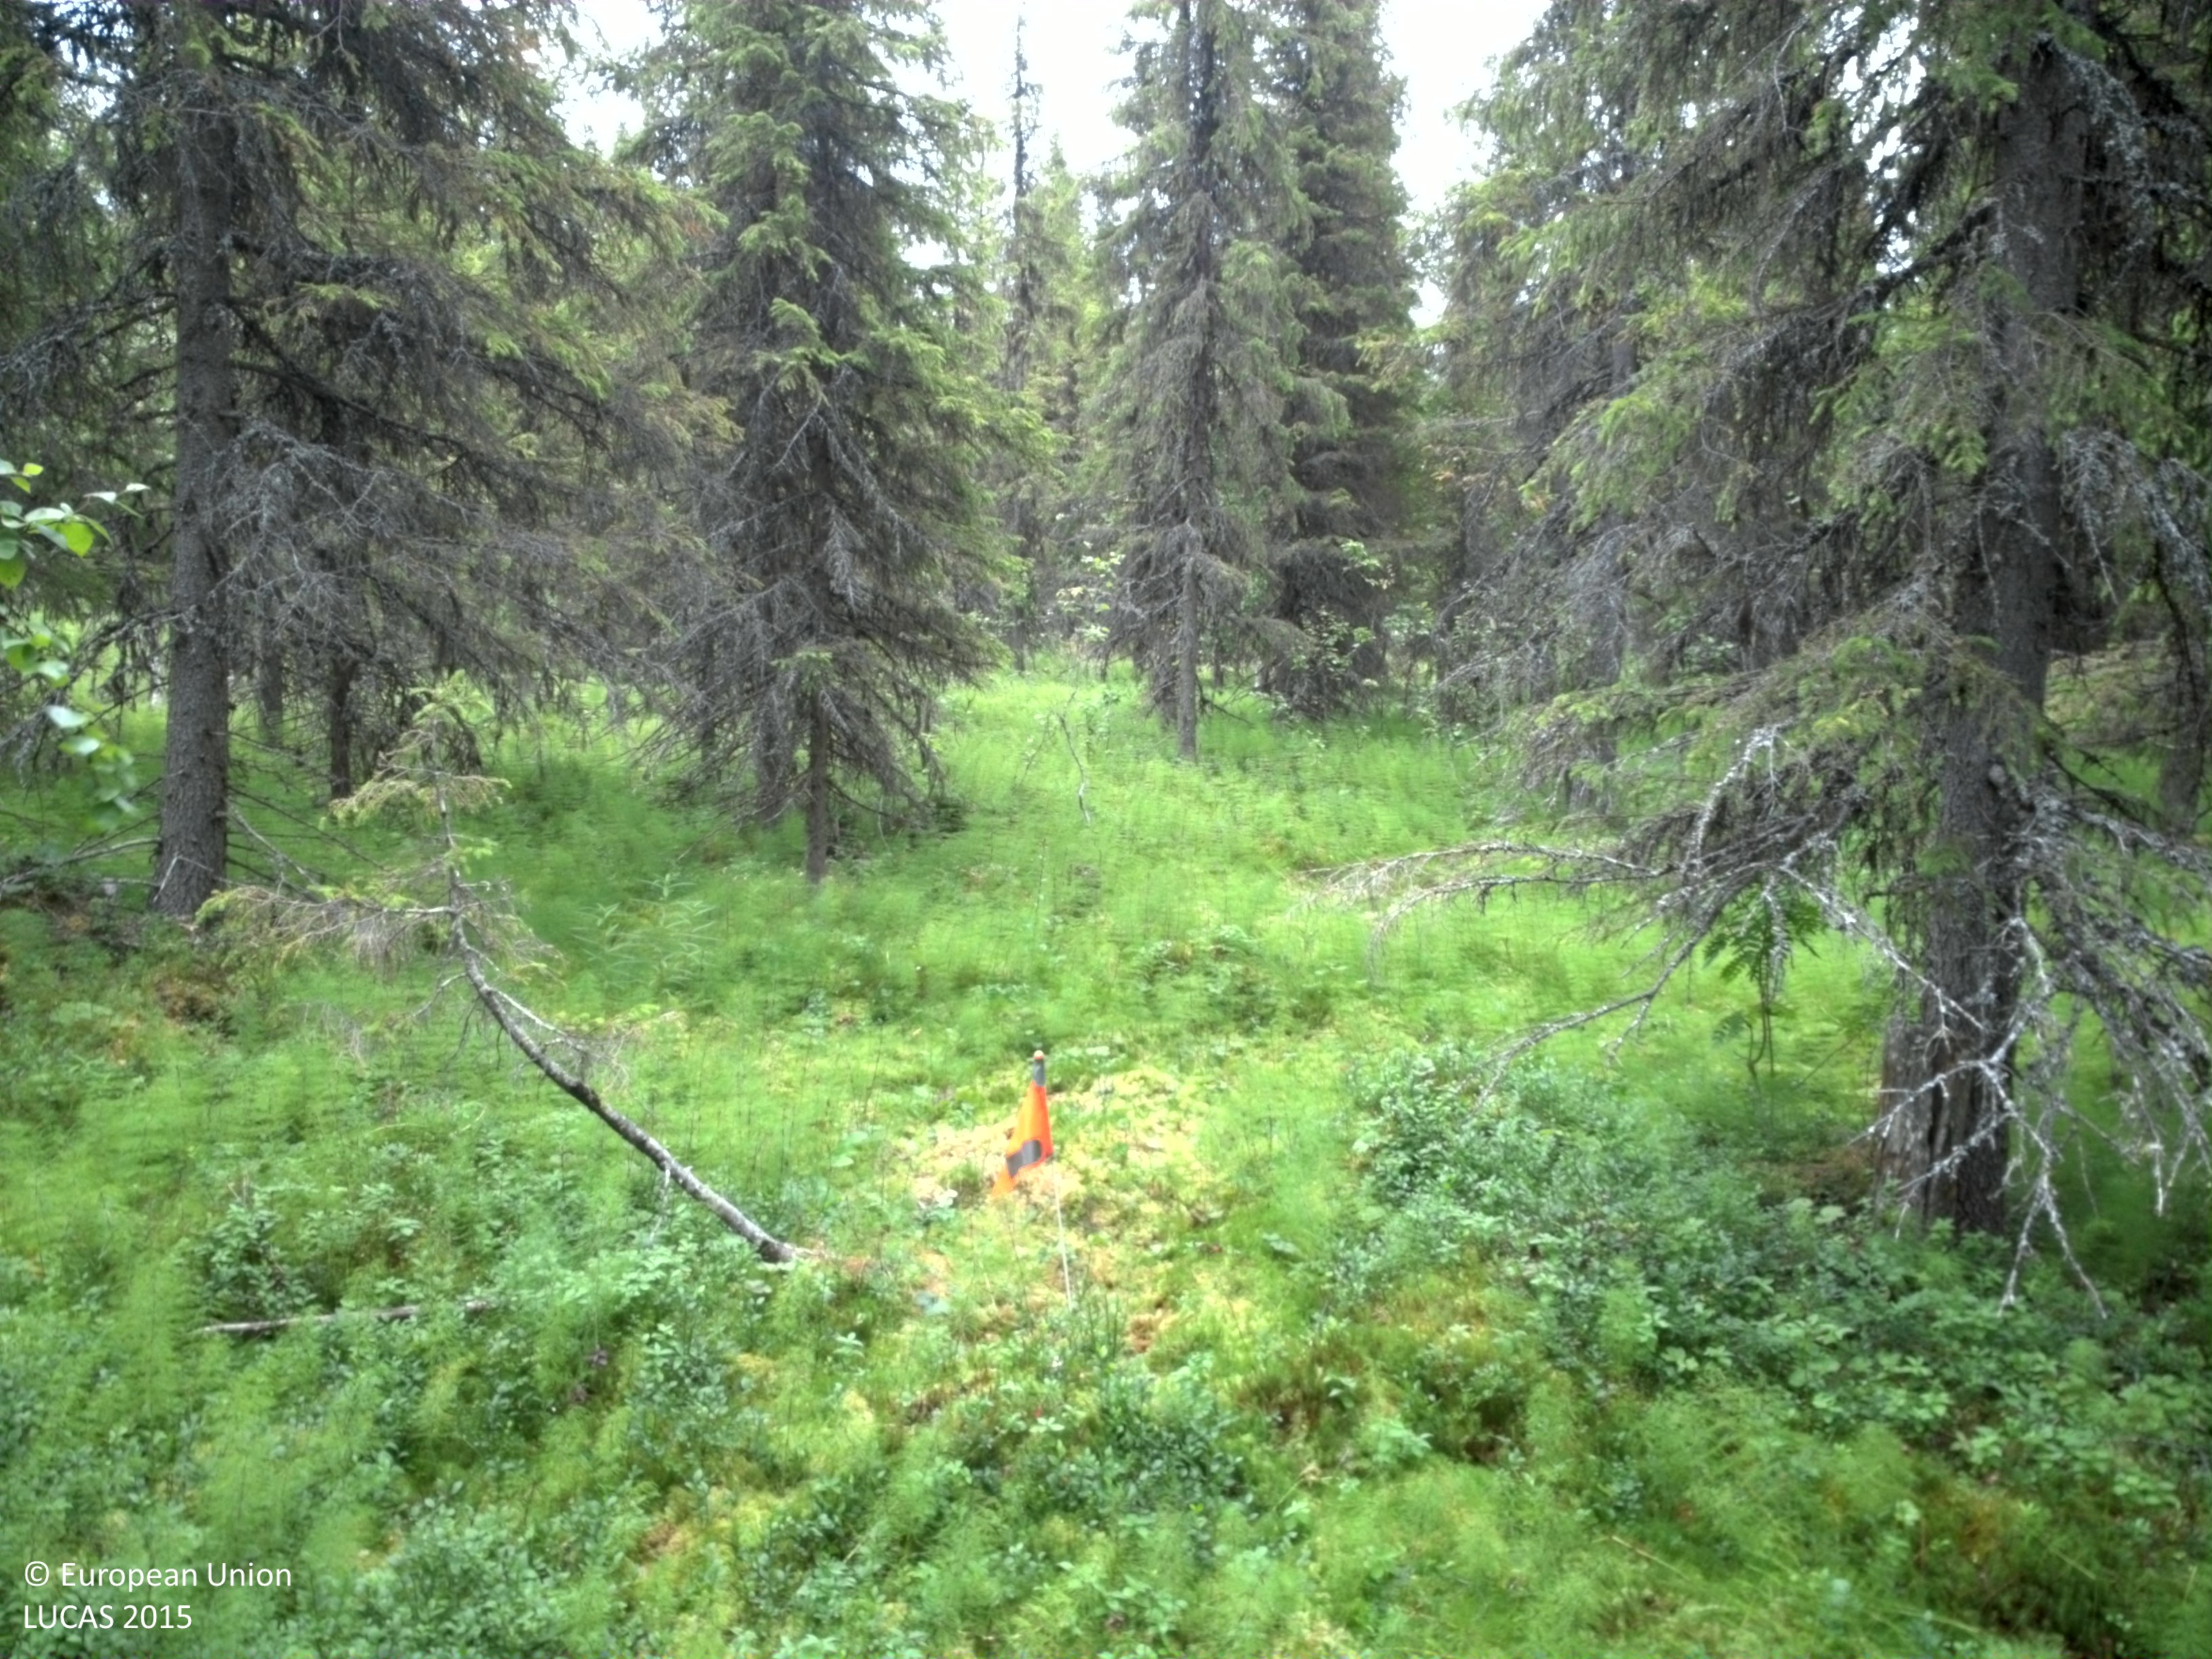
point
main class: Woodland
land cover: Spruce dominated mixed woodland
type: boreal forest
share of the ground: 25 - 50 %
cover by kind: lichens and mosses 35 %, shrubs 20 %, herbaceous plants 20 %, coniferous forest trees 15 %, broadleaved forest trees 10 %
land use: Forestry
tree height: > 5 m
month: August
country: SE
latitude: 64.8605
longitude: 16.5688
